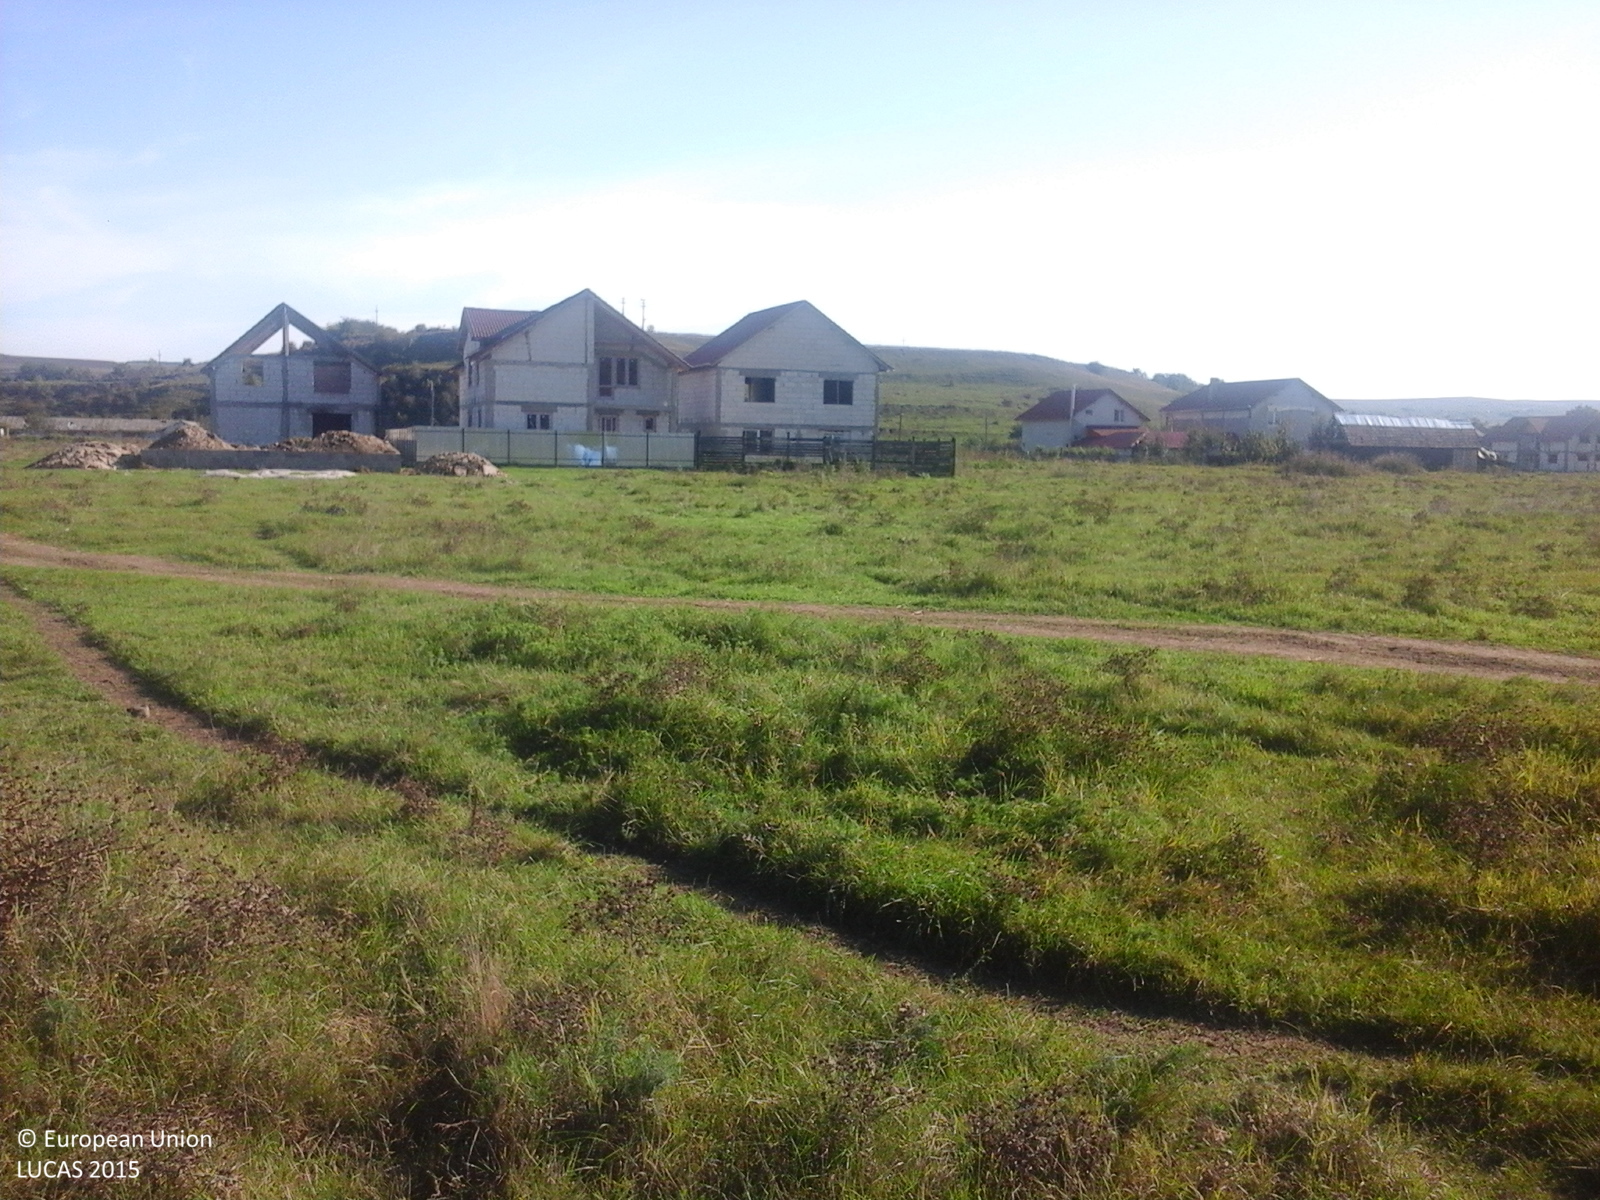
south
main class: Grassland
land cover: Grassland without tree/shrub cover
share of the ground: > 75 %
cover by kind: herbaceous plants 100 %
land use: Agriculture (excluding fallow land and kitchen gardens)
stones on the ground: < 10 %
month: October
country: RO
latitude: 46.1699
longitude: 23.8926
